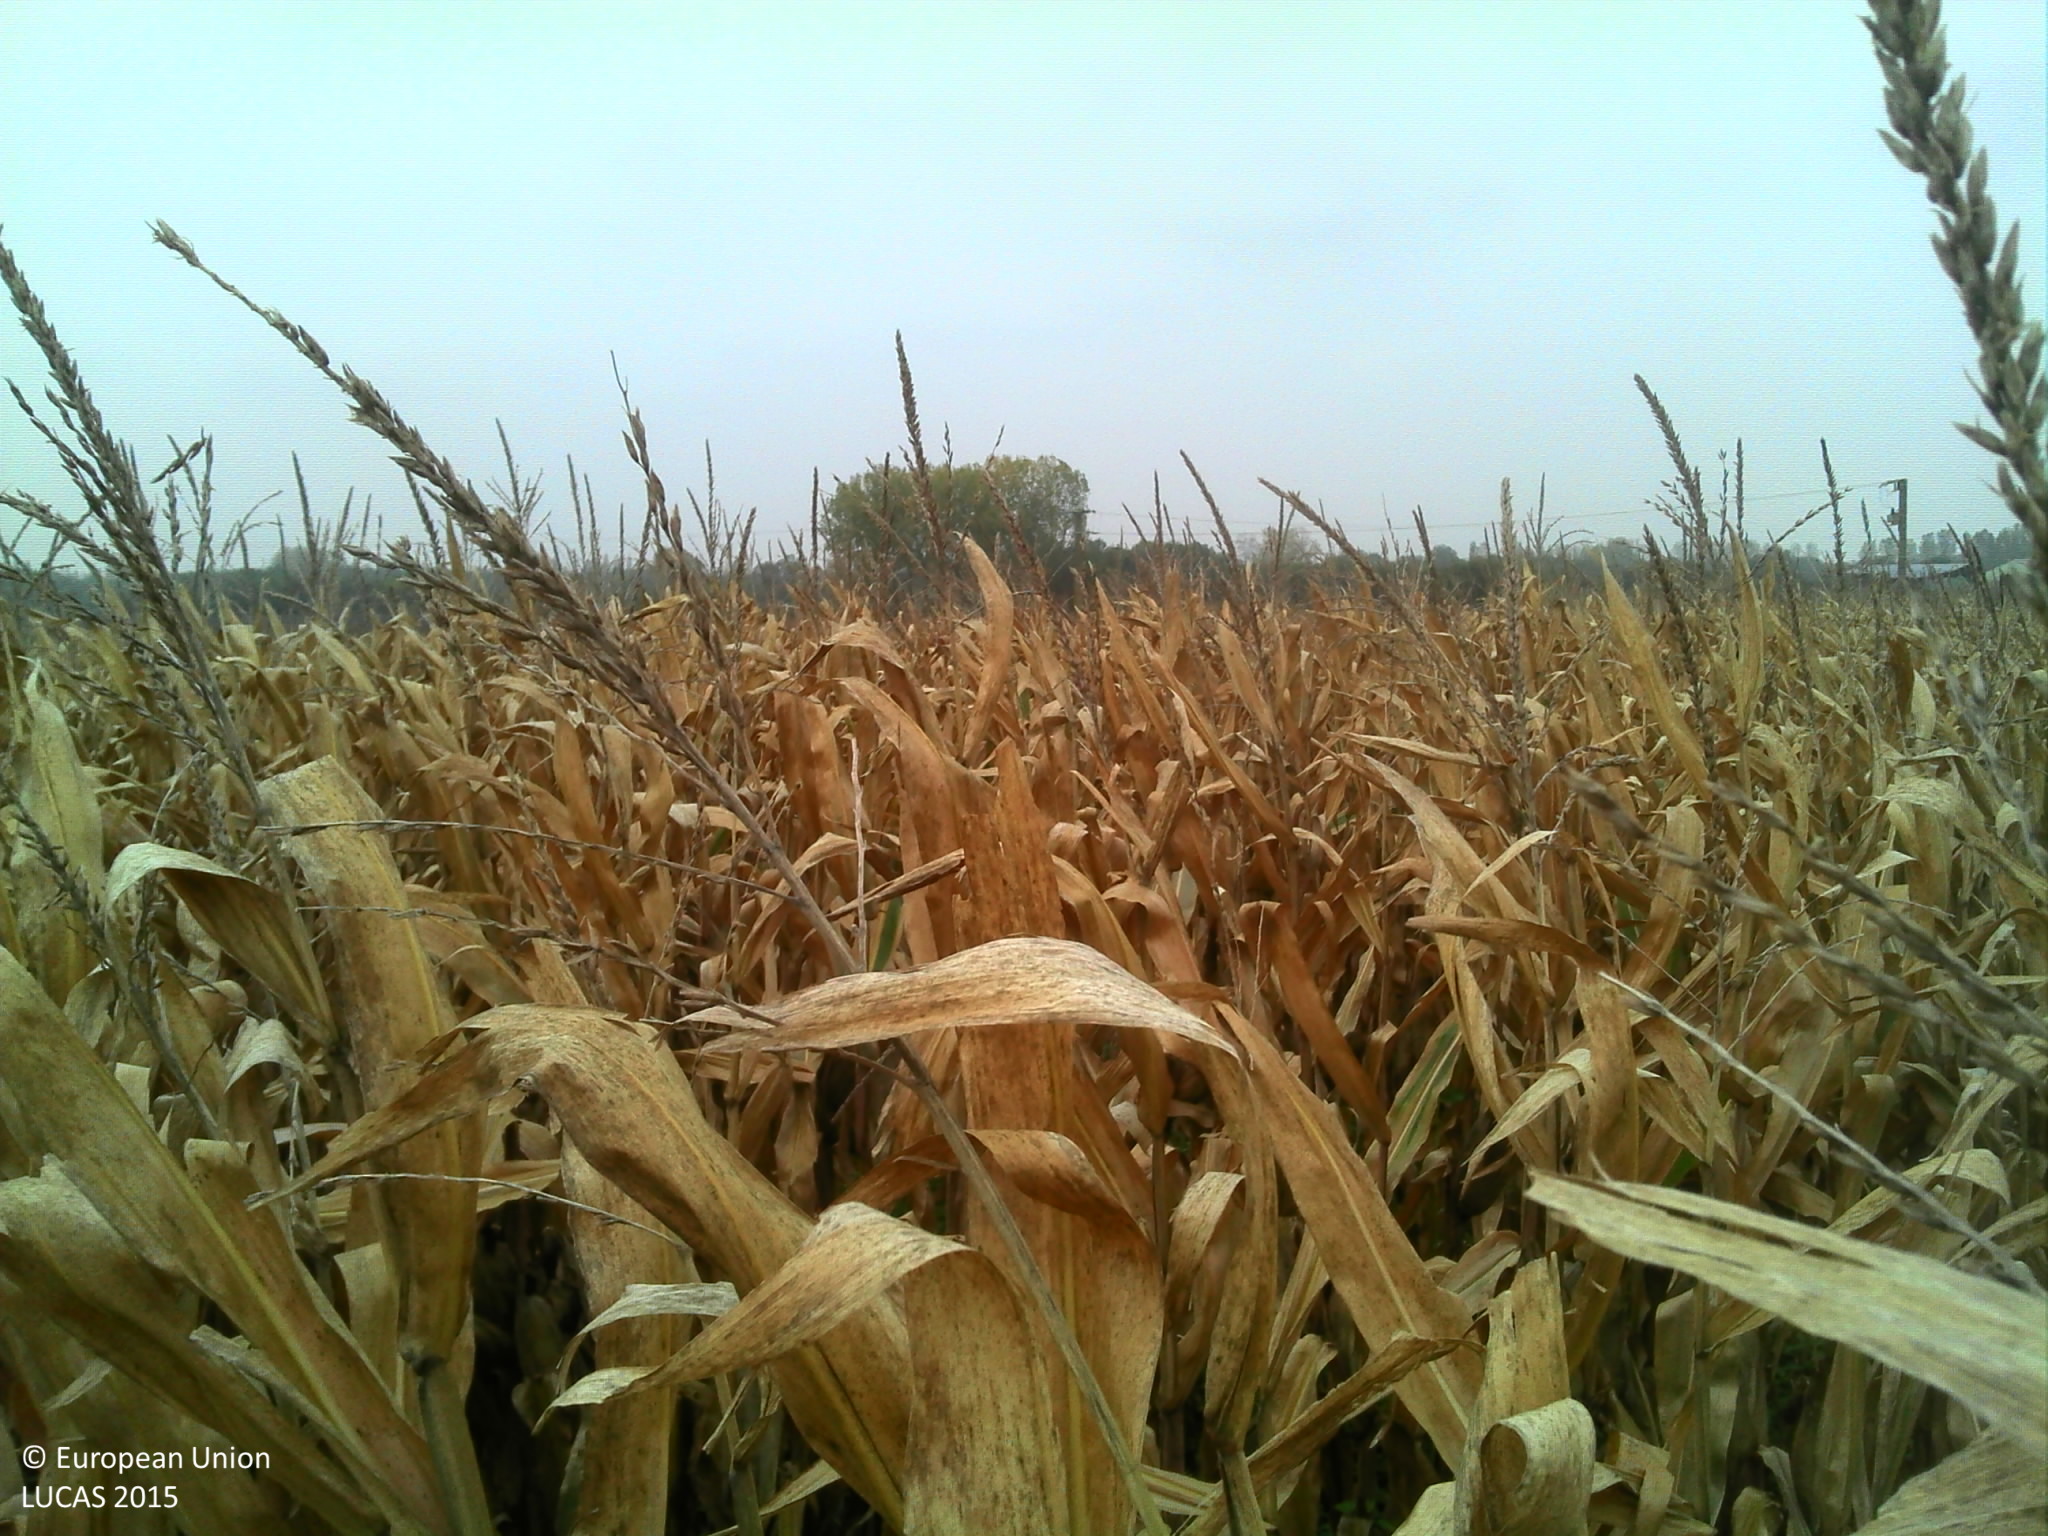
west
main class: Cropland
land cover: Maize
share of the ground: 25 - 50 %
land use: Agriculture (excluding fallow land and kitchen gardens)
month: October
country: FR
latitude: 46.4536
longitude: -1.0069
